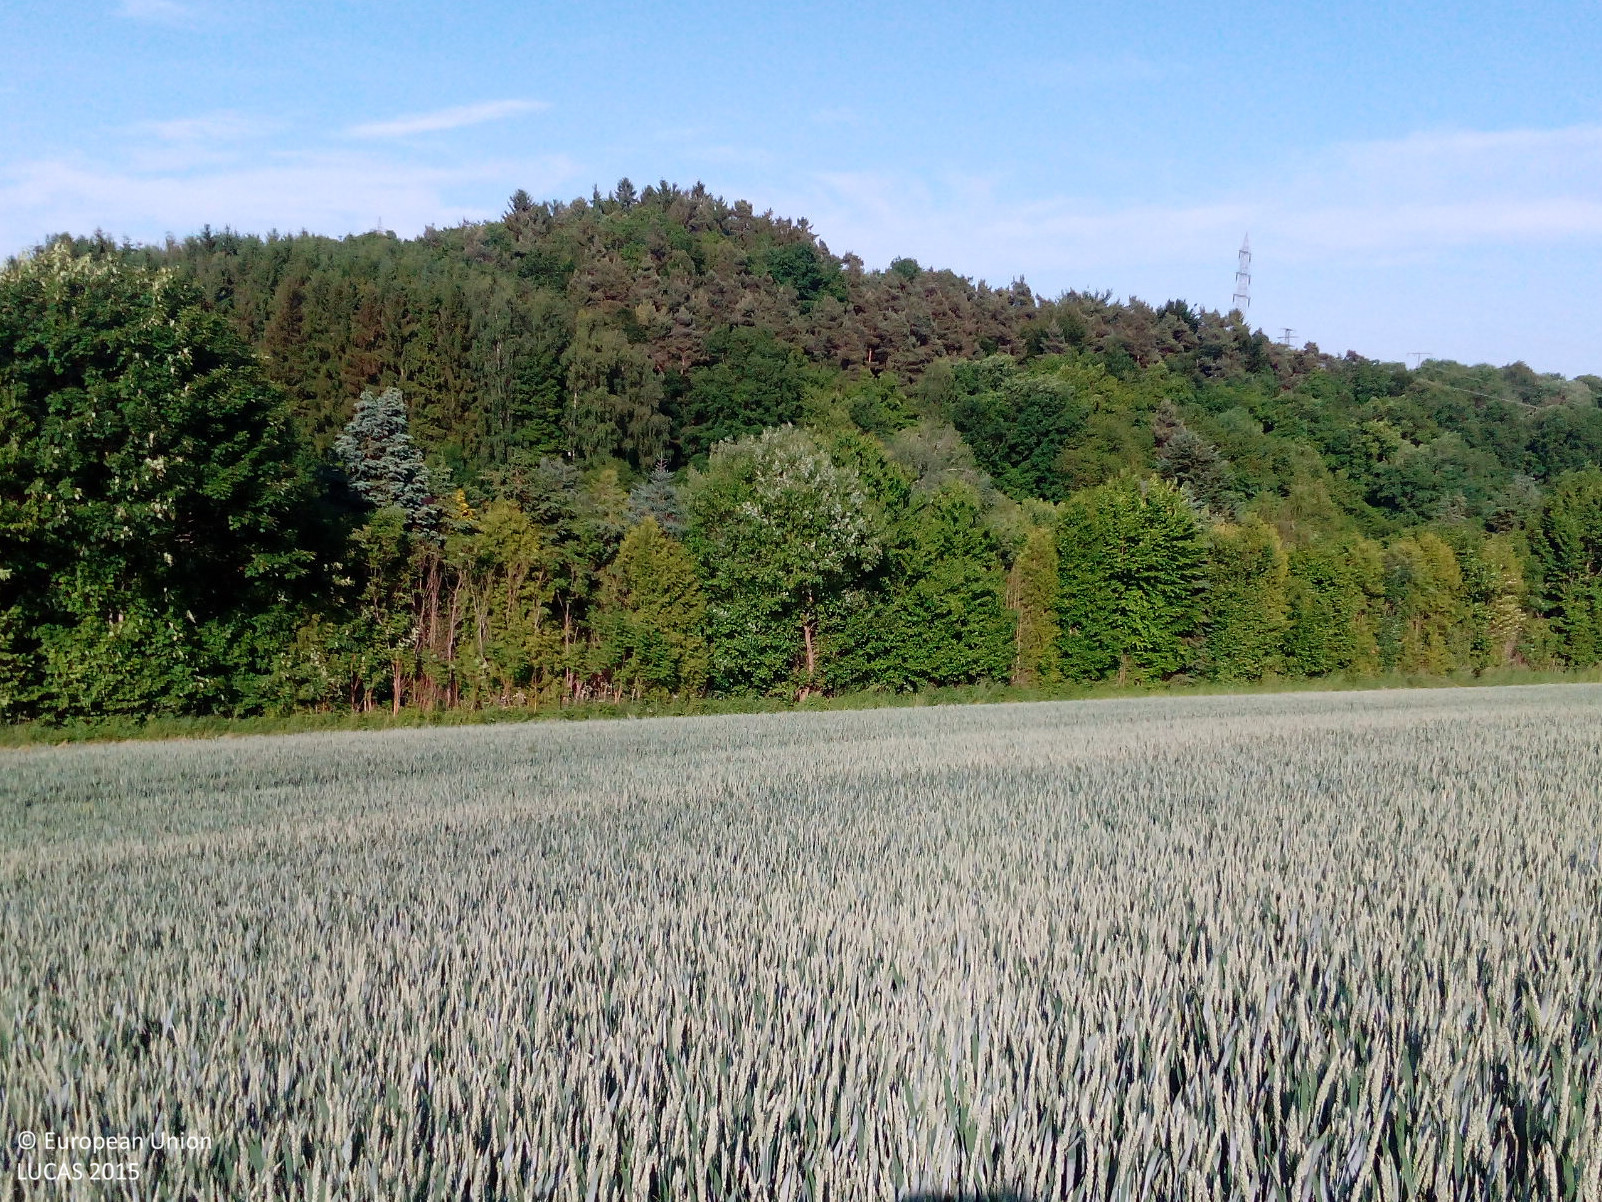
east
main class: Cropland
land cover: Common wheat
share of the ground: > 75 %
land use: Agriculture (excluding fallow land and kitchen gardens)
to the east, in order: Common wheat; Grassland without tree/shrub cover; Broadleaved woodland; Artificial constructions in urban areas; Grassland without tree/shrub cover; Fences; Shrubland with sparse tree cover; Paved roads, cycling and walking lanes; Broadleaved woodland; Spruce dominated mixed woodland
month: June
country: DE
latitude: 50.1511
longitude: 8.1390
